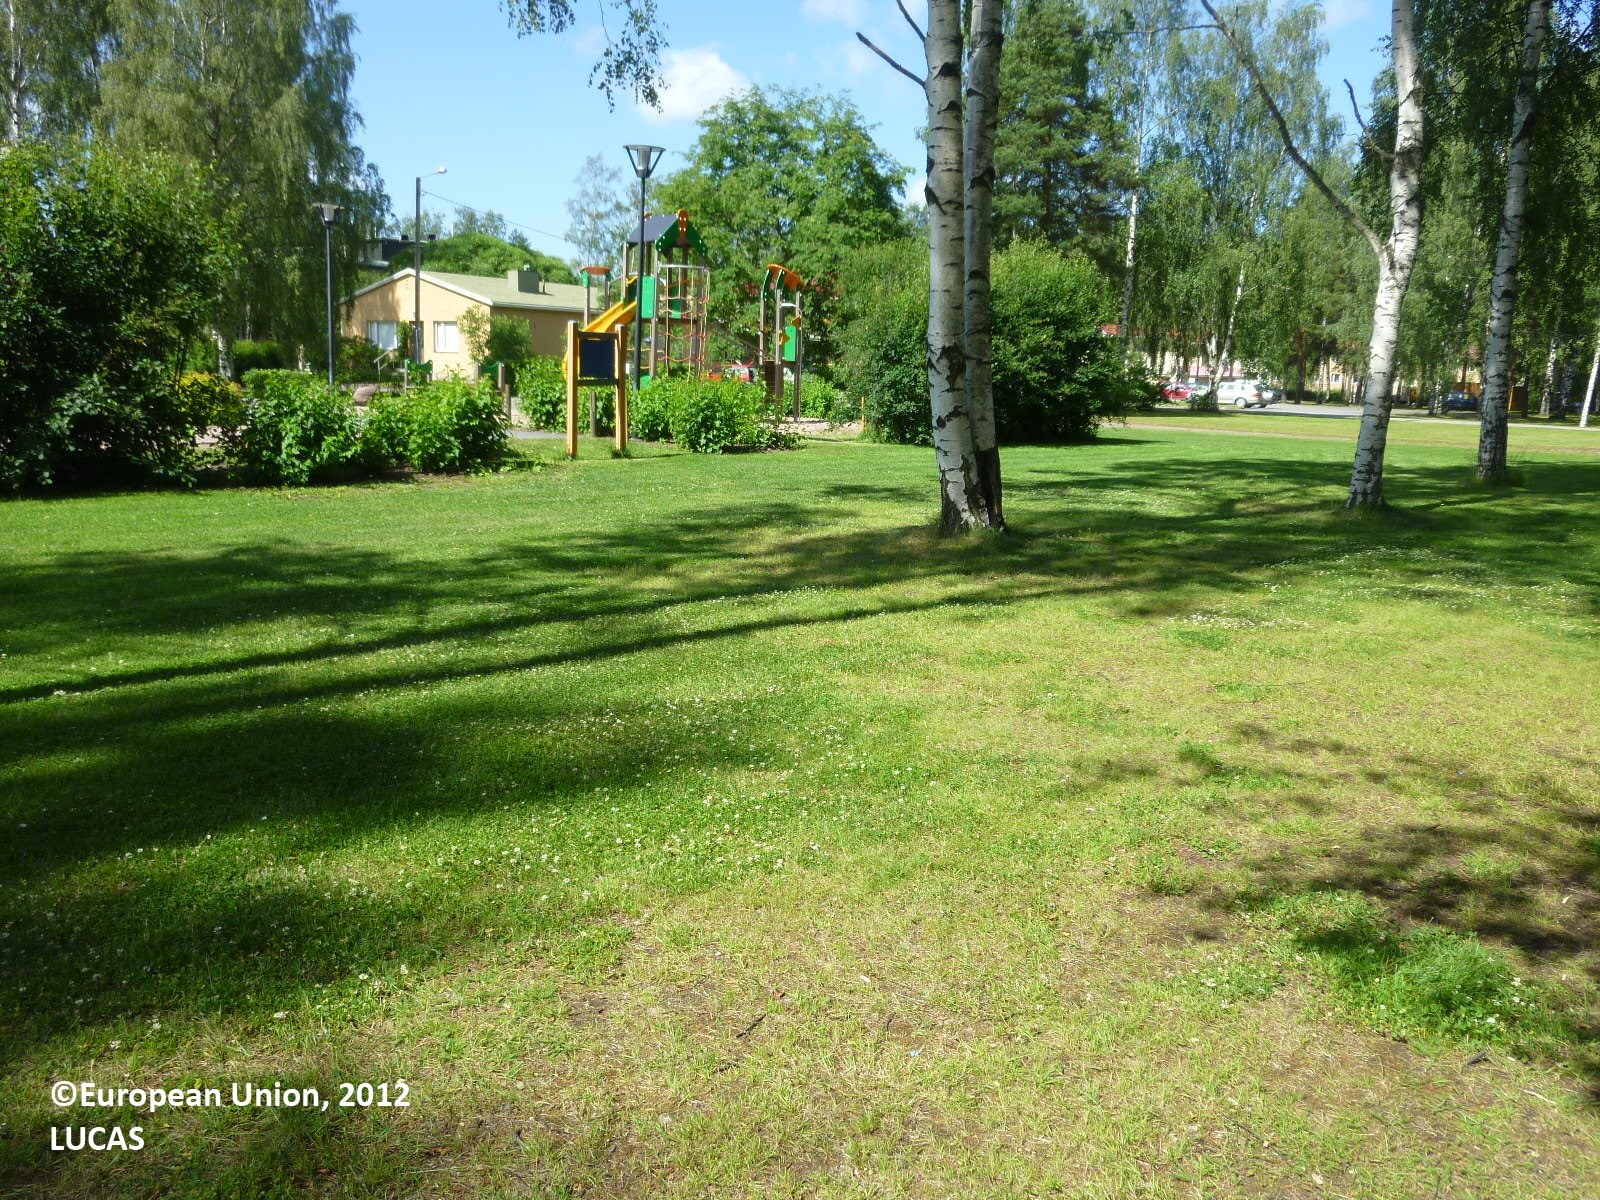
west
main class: Woodland
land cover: Broadleaved woodland
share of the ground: 50 - 75 %
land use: Amenities, museums, leisure
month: July
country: FI
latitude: 61.3149
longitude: 22.1431
